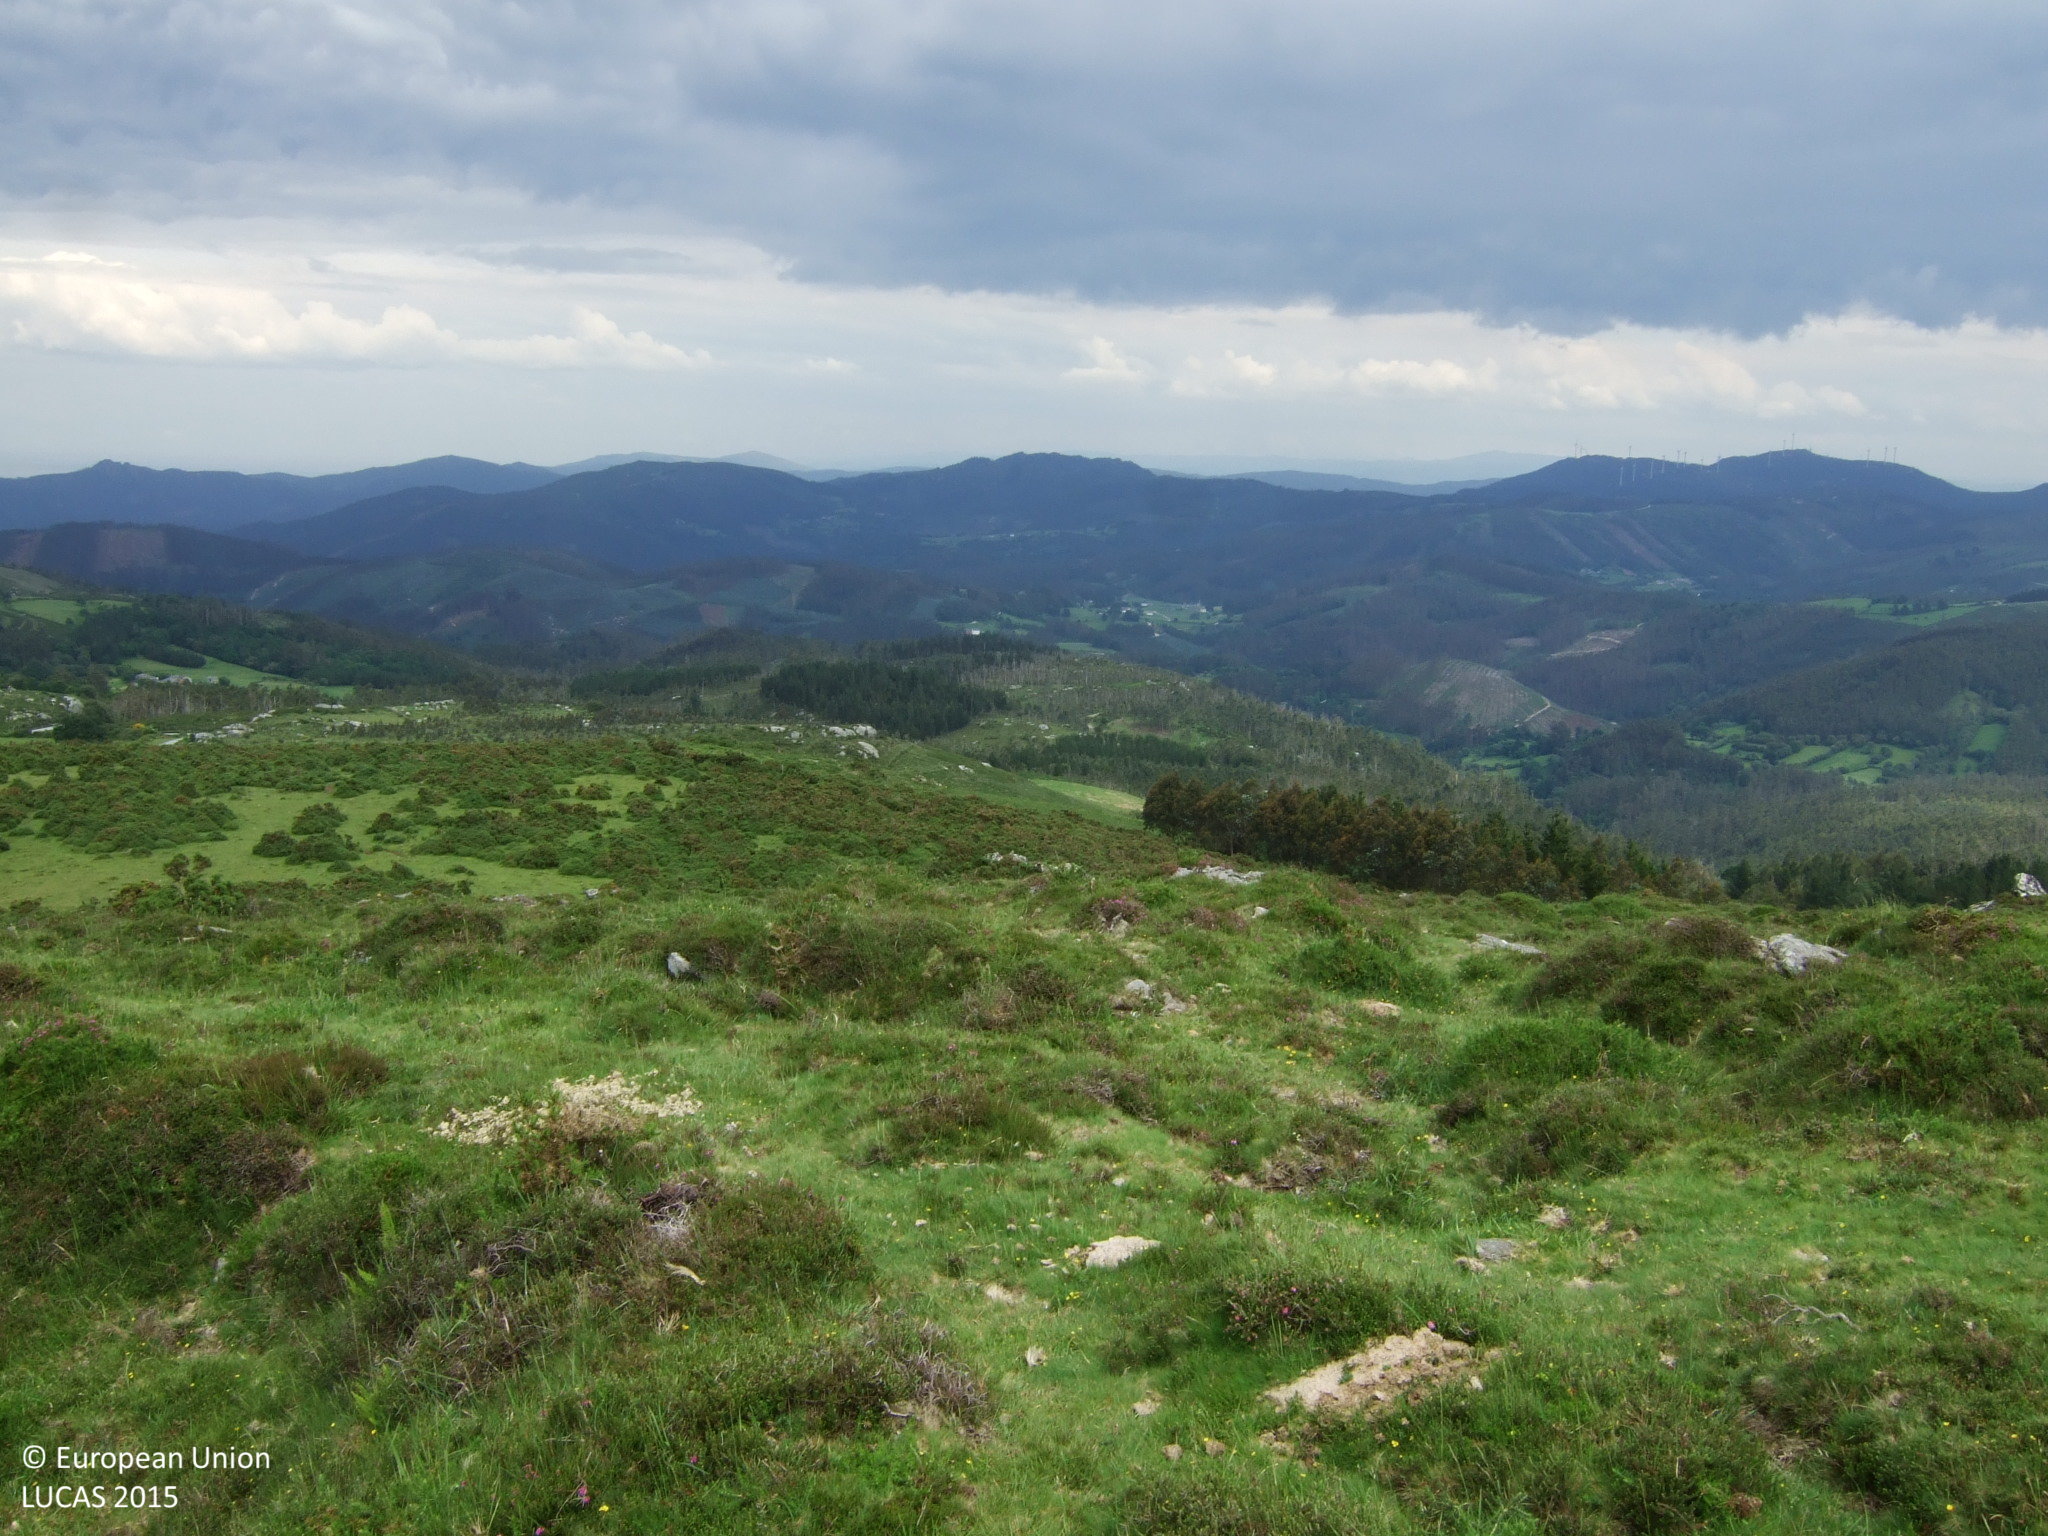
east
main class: Shrubland
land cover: Shrubland without tree cover
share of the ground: > 75 %
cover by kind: herbaceous plants 60 %, shrubs 40 %
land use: Agriculture (excluding fallow land and kitchen gardens)
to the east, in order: Shrubland without tree cover; Grassland without tree/shrub cover; Shrubland without tree cover
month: June
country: ES
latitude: 43.4889
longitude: -7.5296
